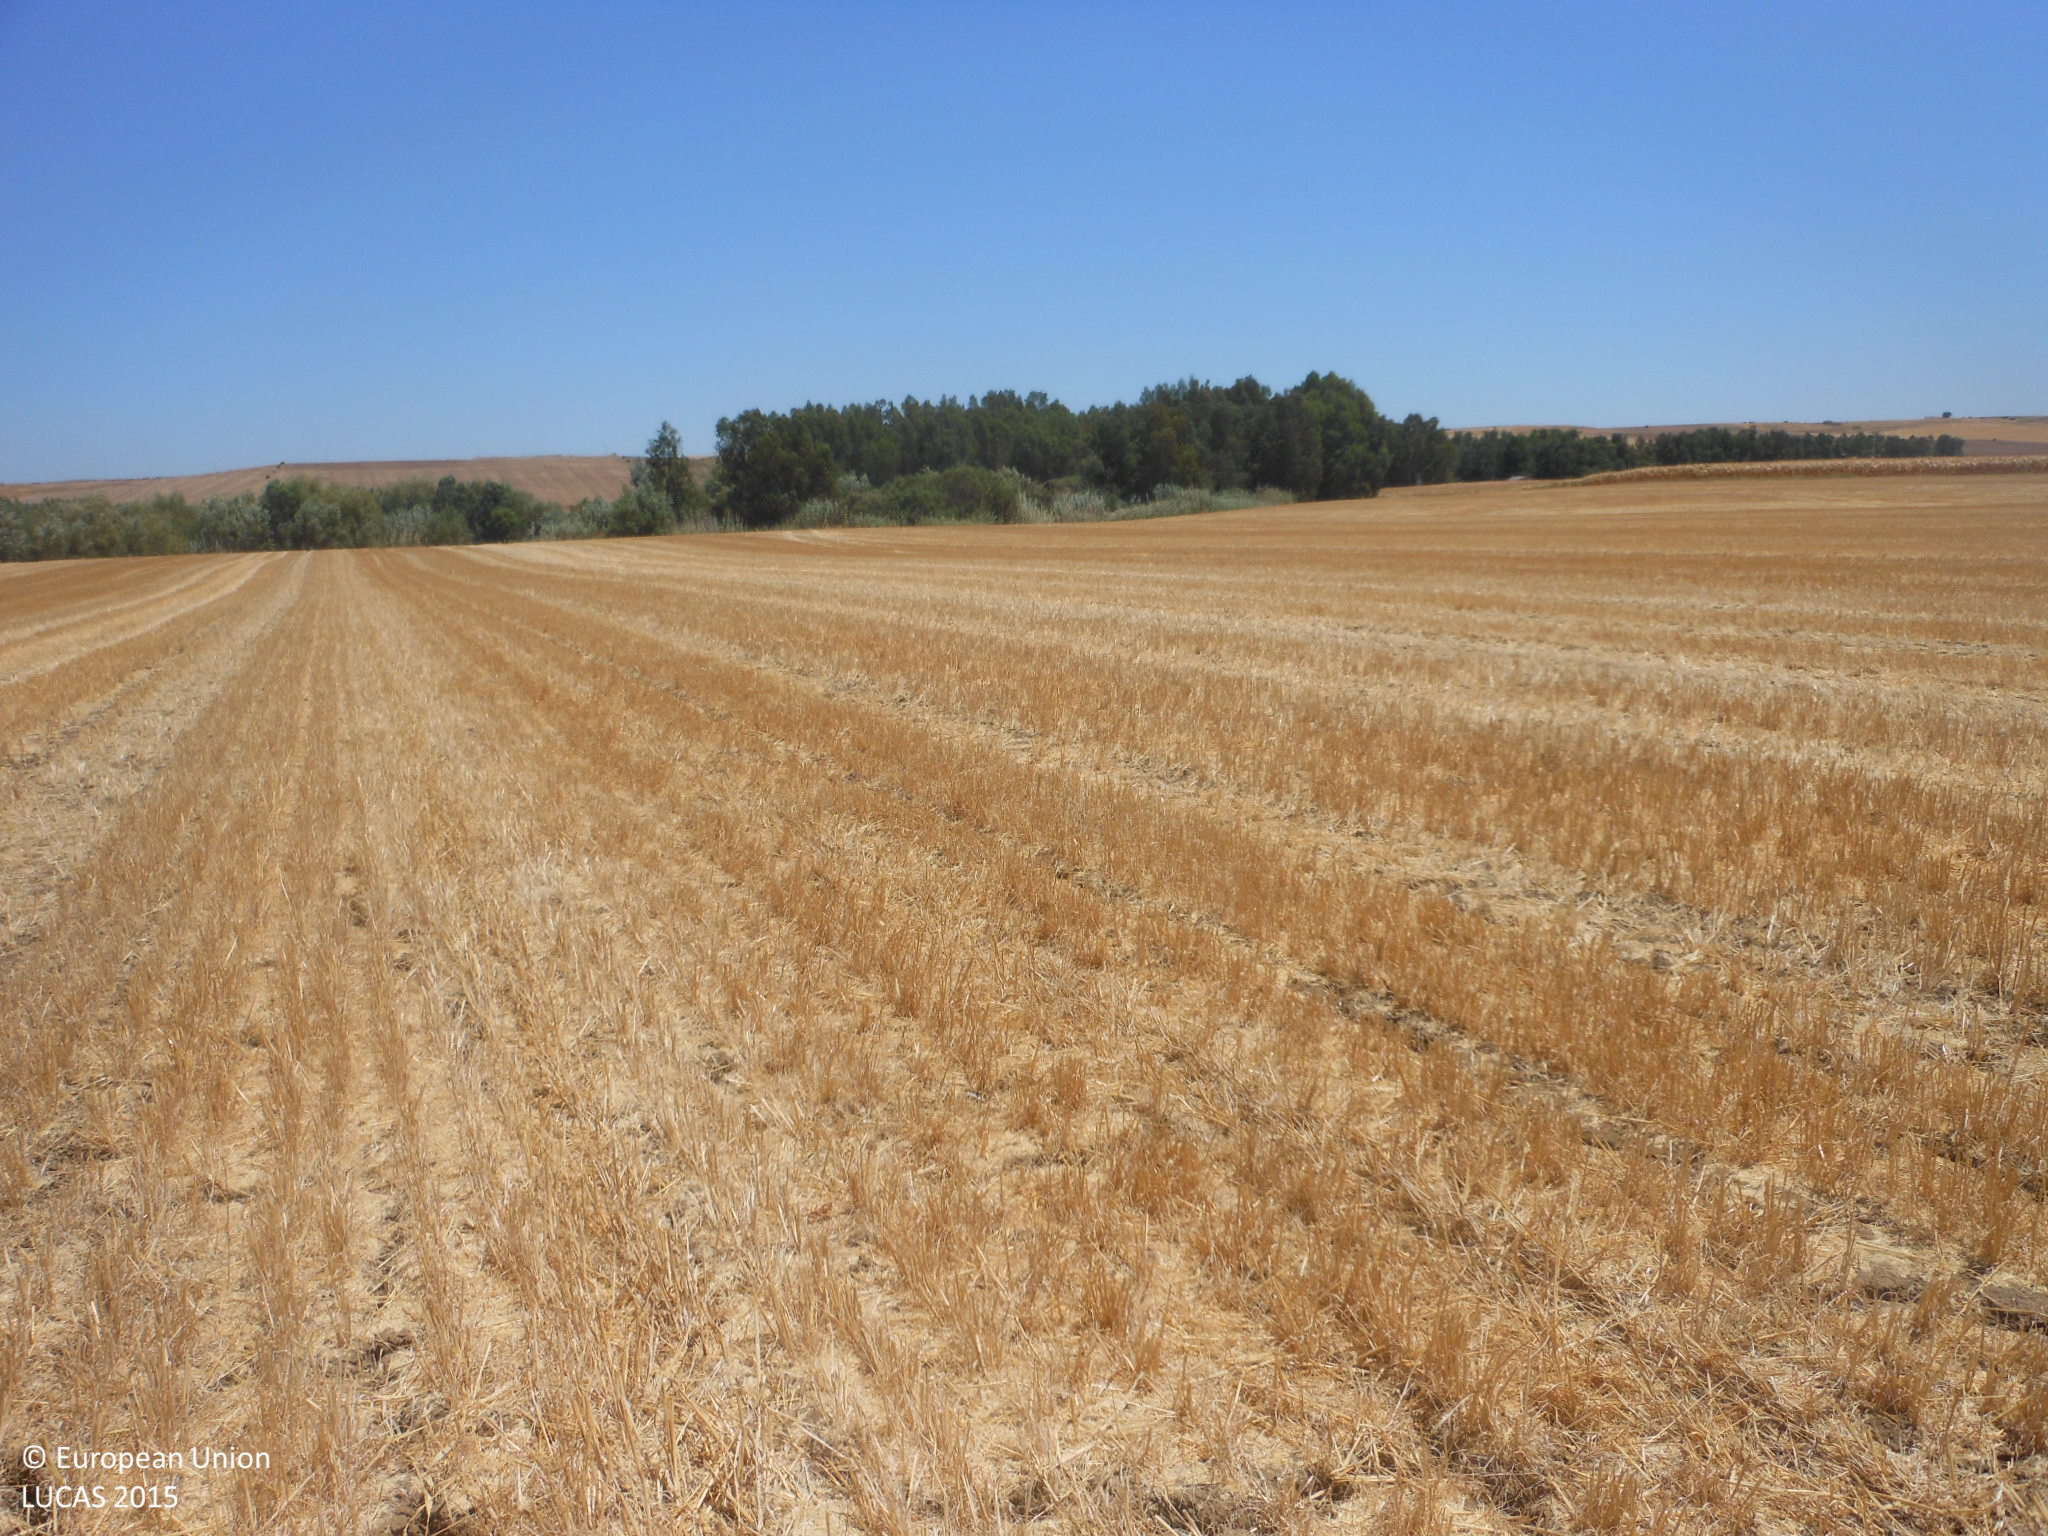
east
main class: Cropland
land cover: Barley
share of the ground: < 10 %
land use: Agriculture (excluding fallow land and kitchen gardens)
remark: Harvested field
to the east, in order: Barley; Rivers and streams; Barley
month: July
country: ES
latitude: 37.5556
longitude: -5.6082
